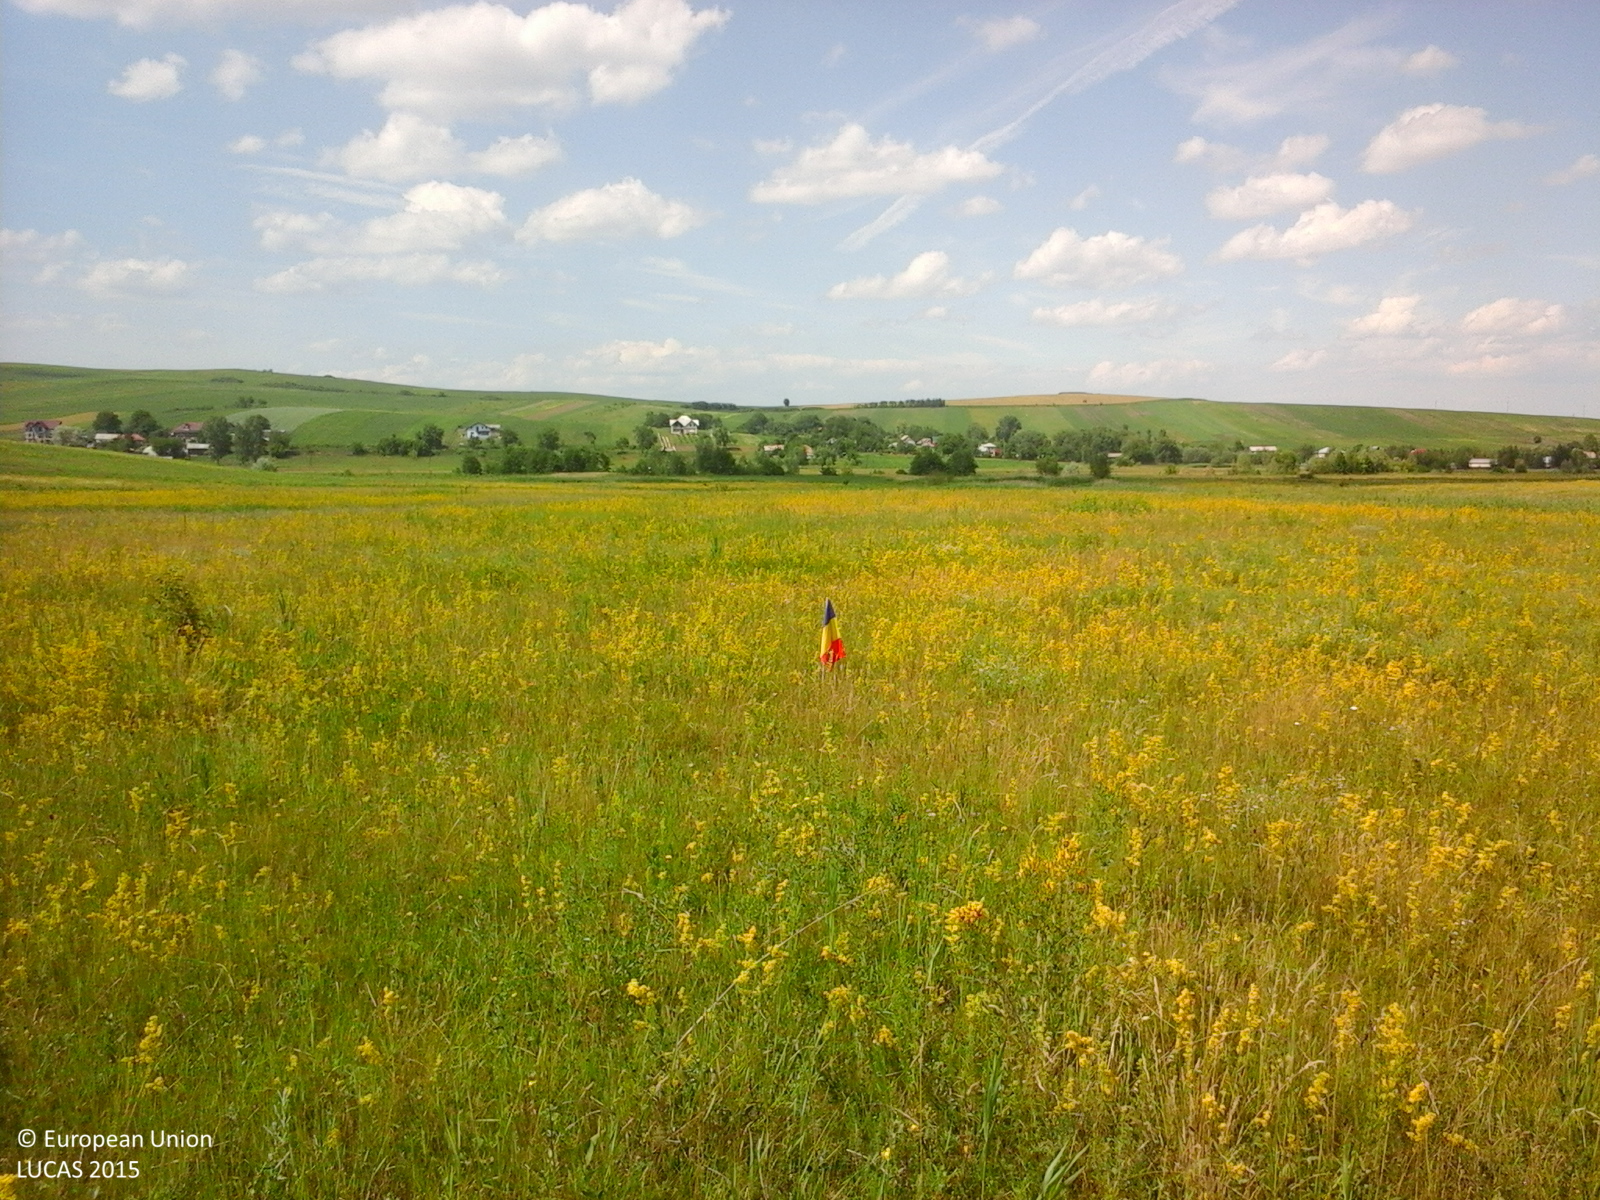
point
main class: Grassland
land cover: Grassland without tree/shrub cover
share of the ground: > 75 %
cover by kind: herbaceous plants 100 %
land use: Agriculture (excluding fallow land and kitchen gardens)
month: June
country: RO
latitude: 47.9068
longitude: 26.3696
